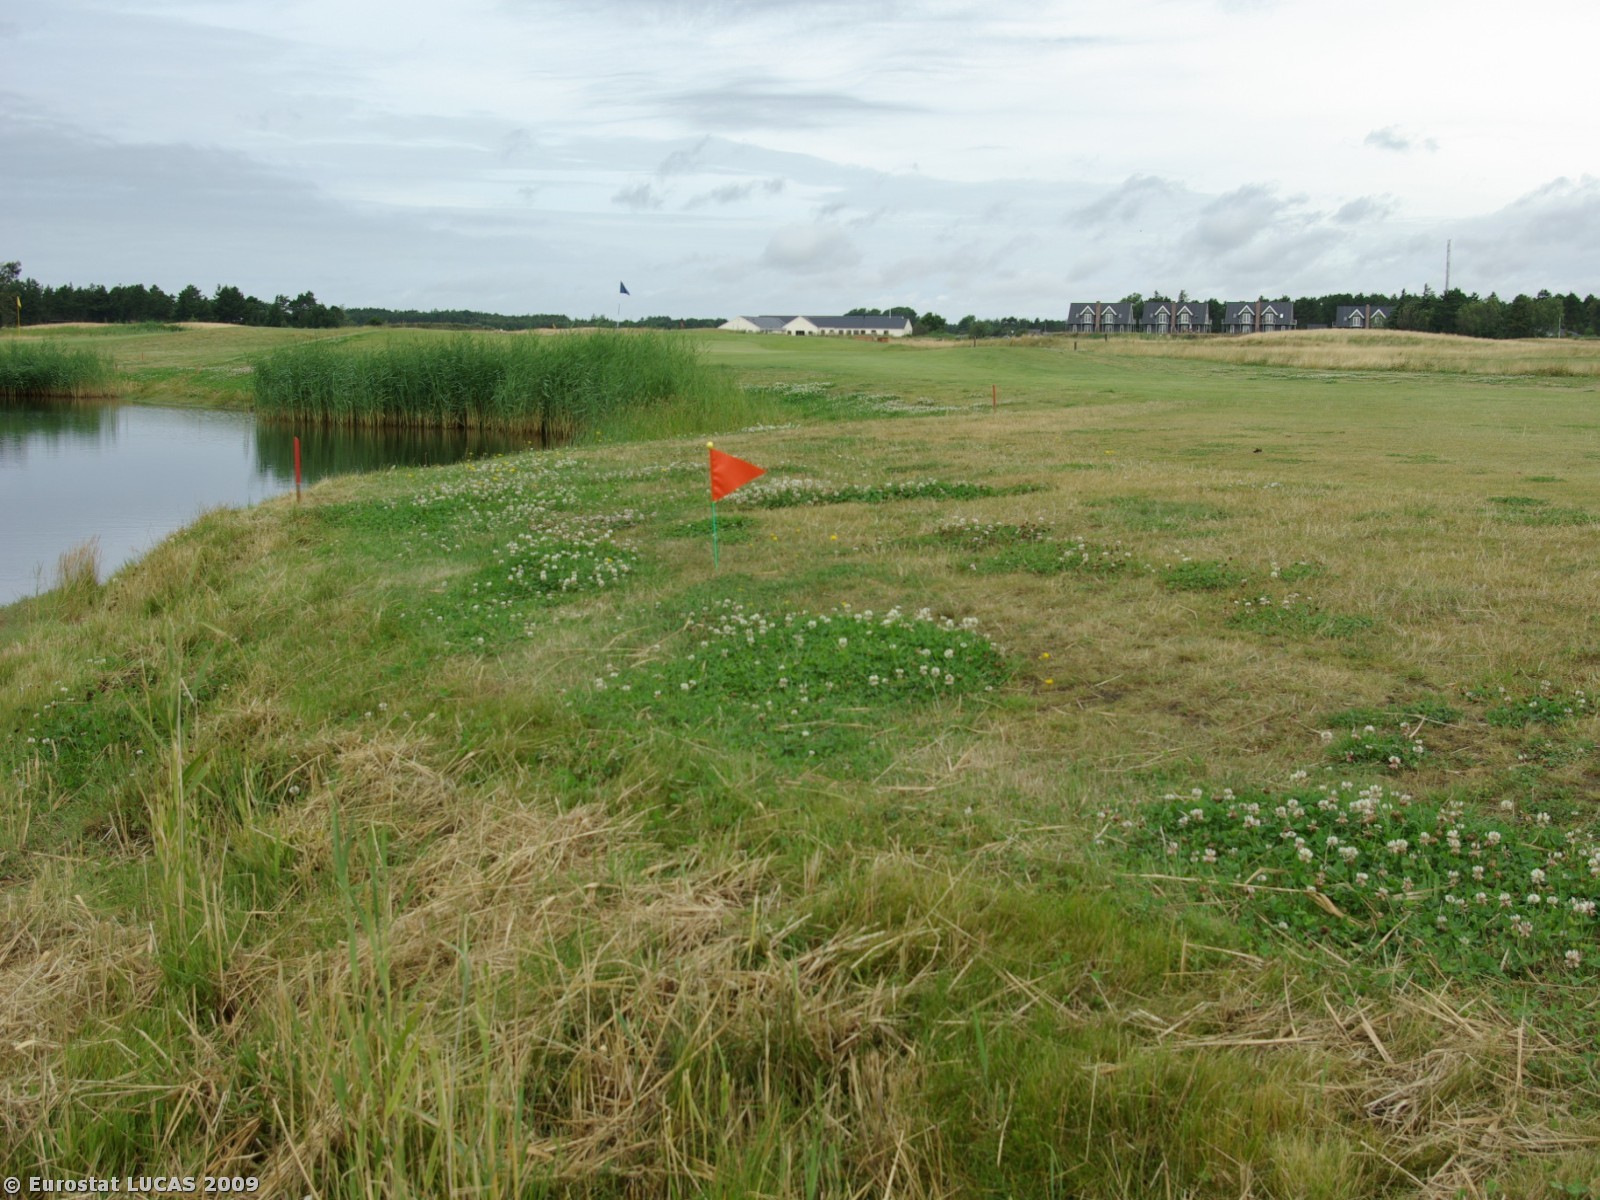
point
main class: Grassland
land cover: Grassland without tree/shrub cover
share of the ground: > 75 %
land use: Sport
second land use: Amenities, museums, leisure
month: July
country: DK
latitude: 55.0829
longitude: 8.5442
